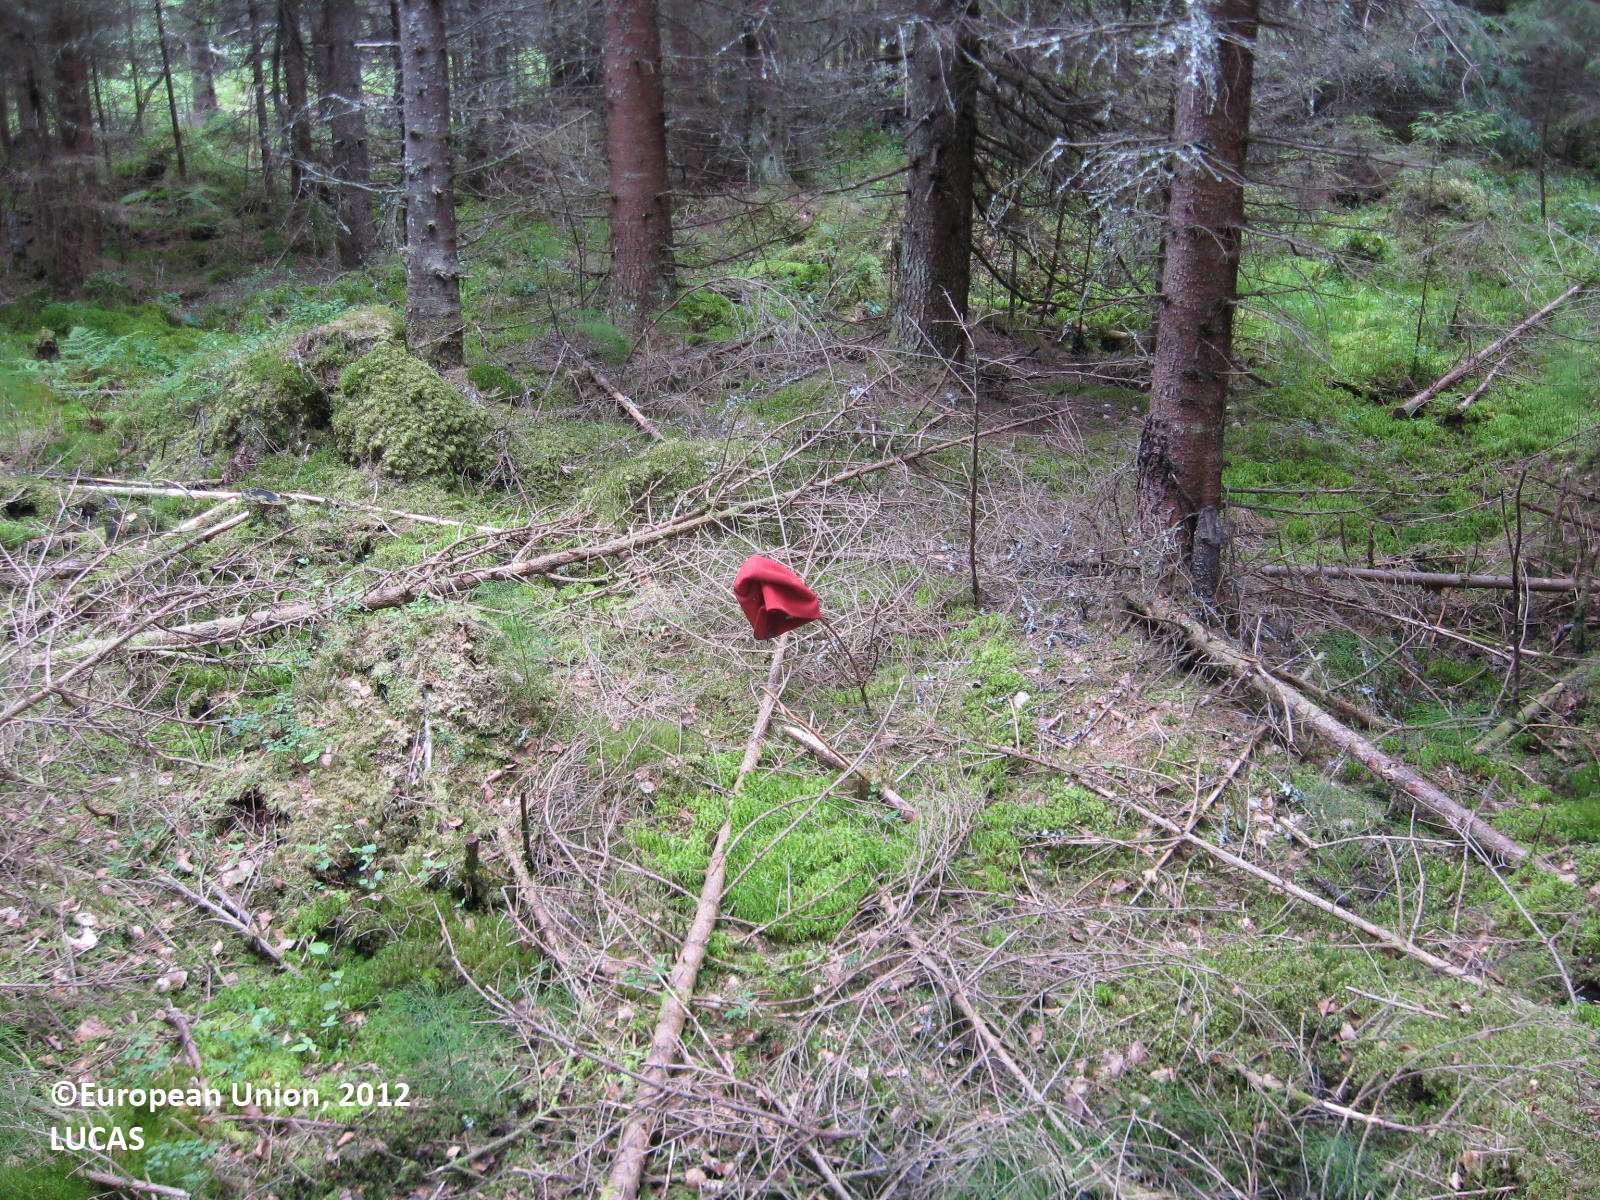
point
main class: Woodland
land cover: Spruce dominated mixed woodland
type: boreal forest
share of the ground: > 75 %
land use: Forestry
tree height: > 5 m
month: July
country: FI
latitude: 62.0719
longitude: 21.3560
